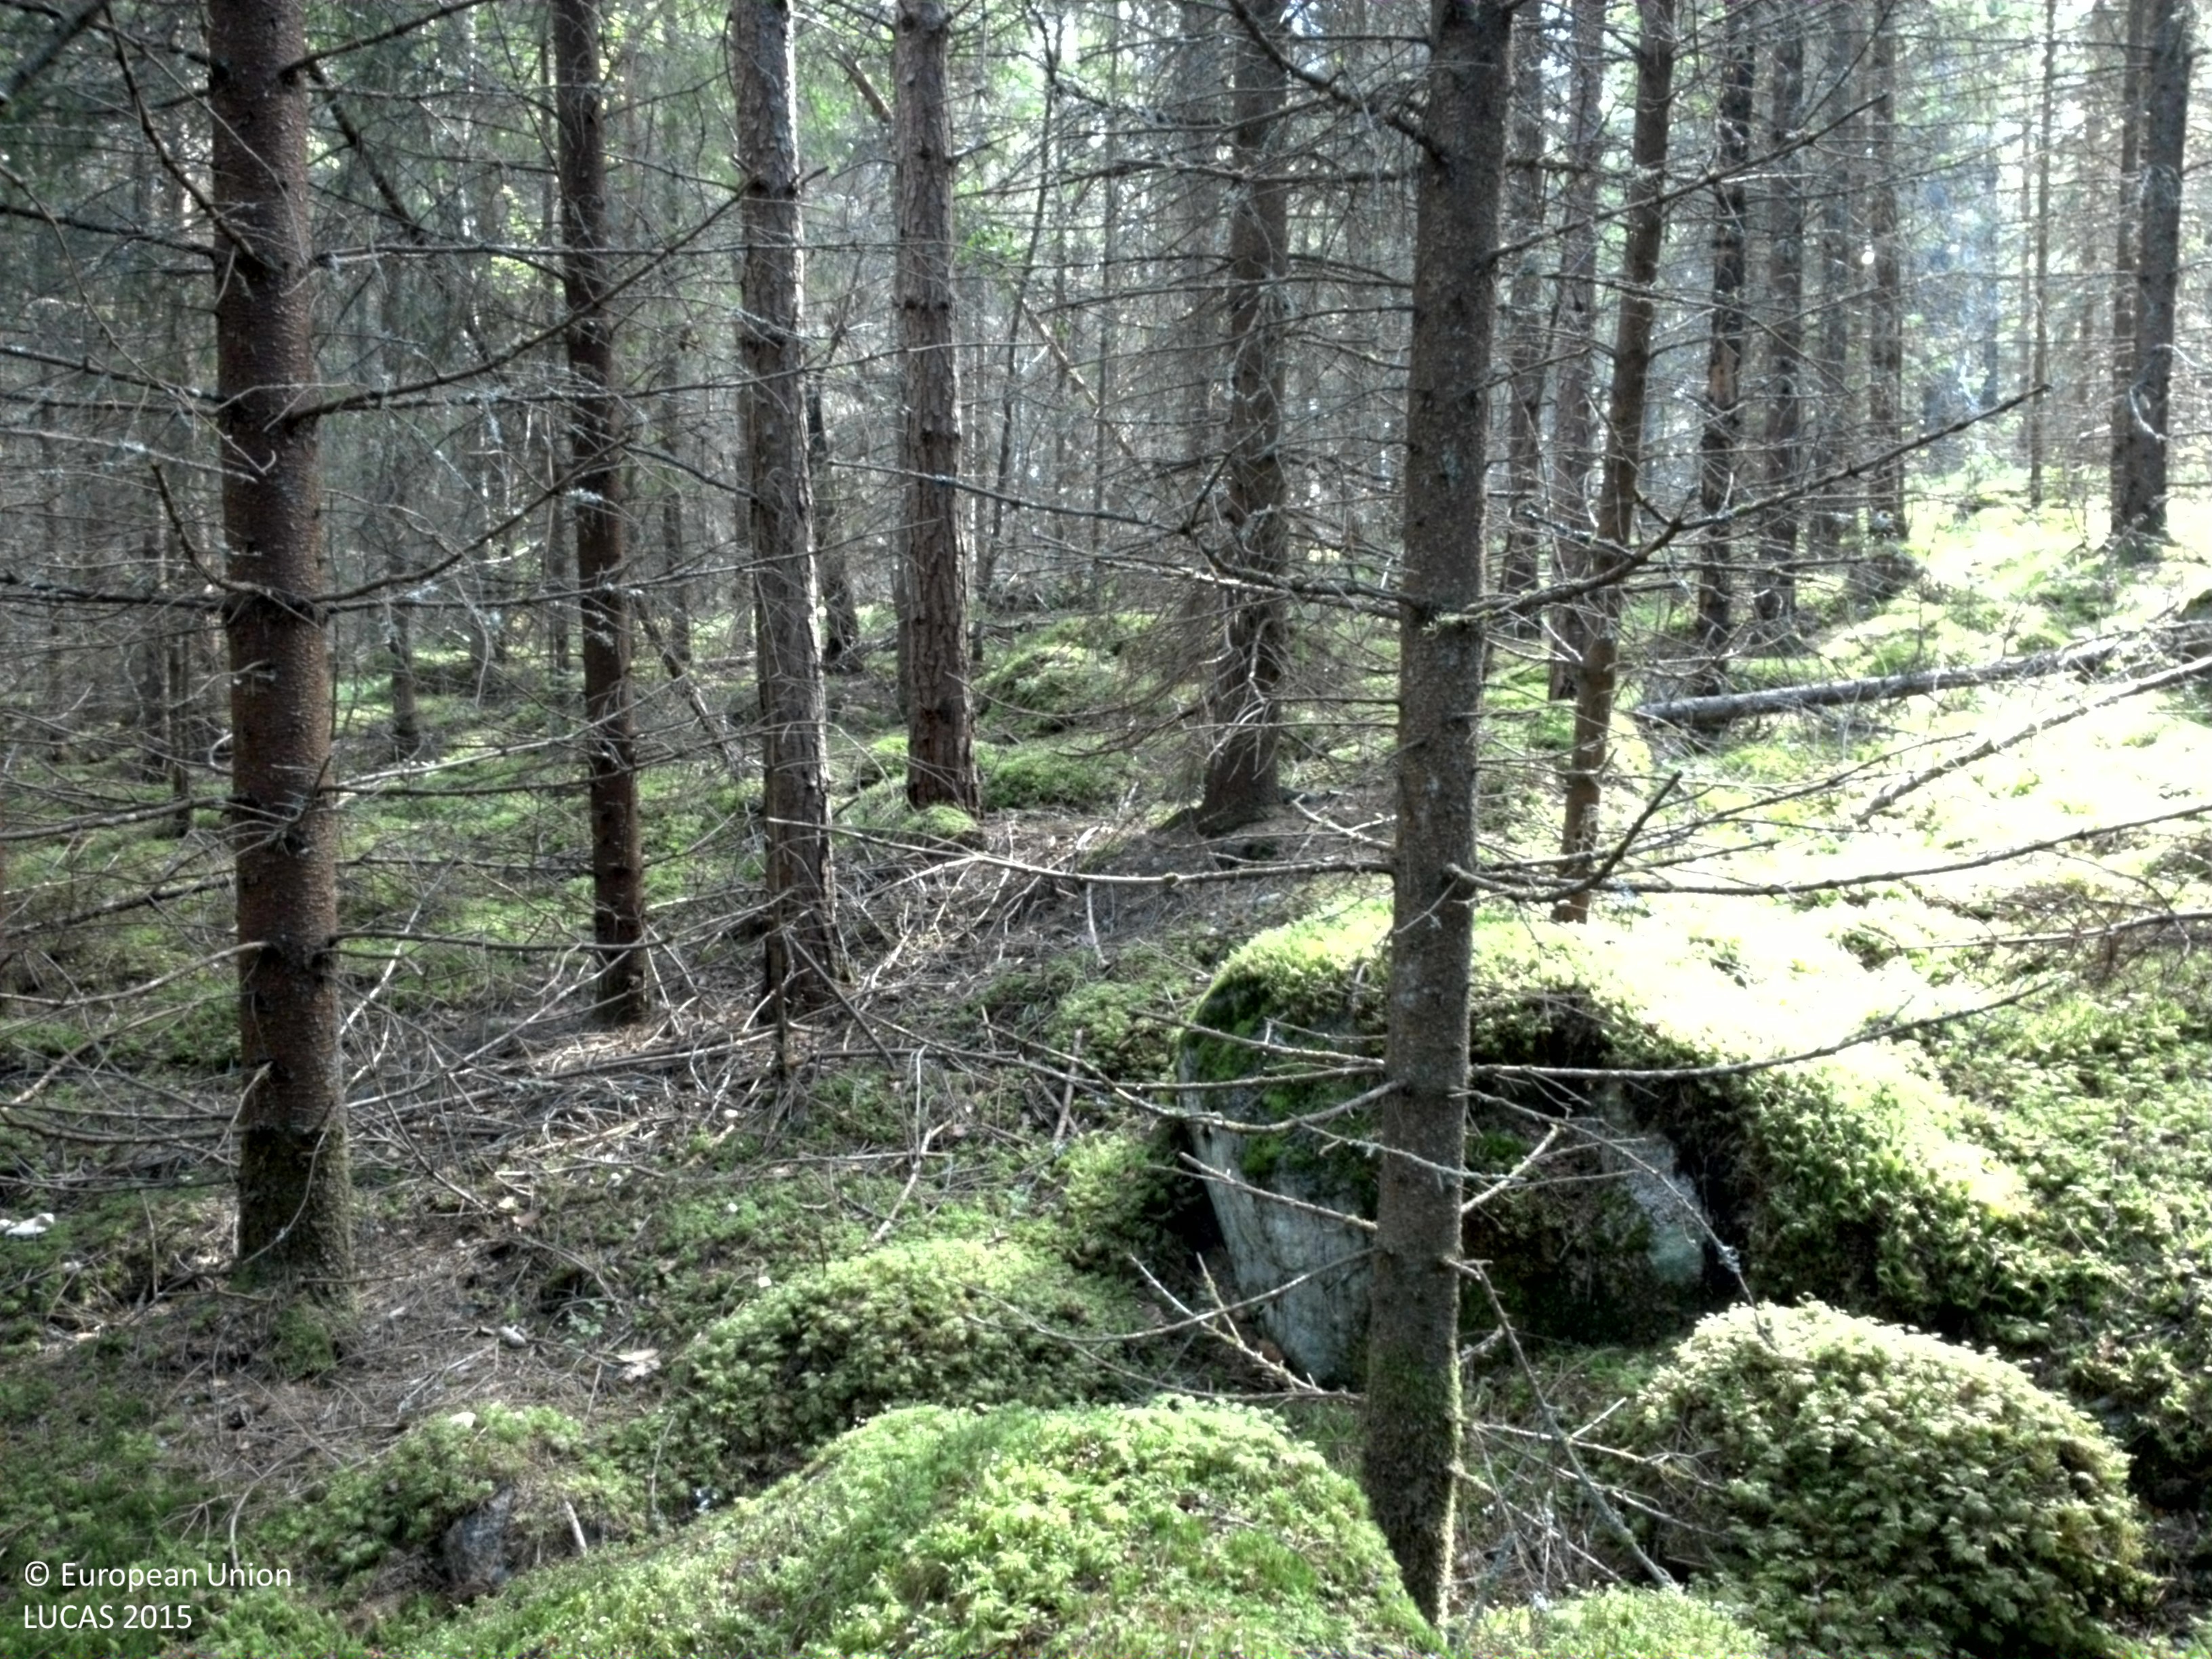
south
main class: Woodland
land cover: Spruce dominated coniferous woodland
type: boreal forest
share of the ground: > 75 %
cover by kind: coniferous forest trees 95 %, lichens and mosses 5 %
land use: Forestry
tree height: > 5 m
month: August
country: SE
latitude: 59.9606
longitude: 16.4557
